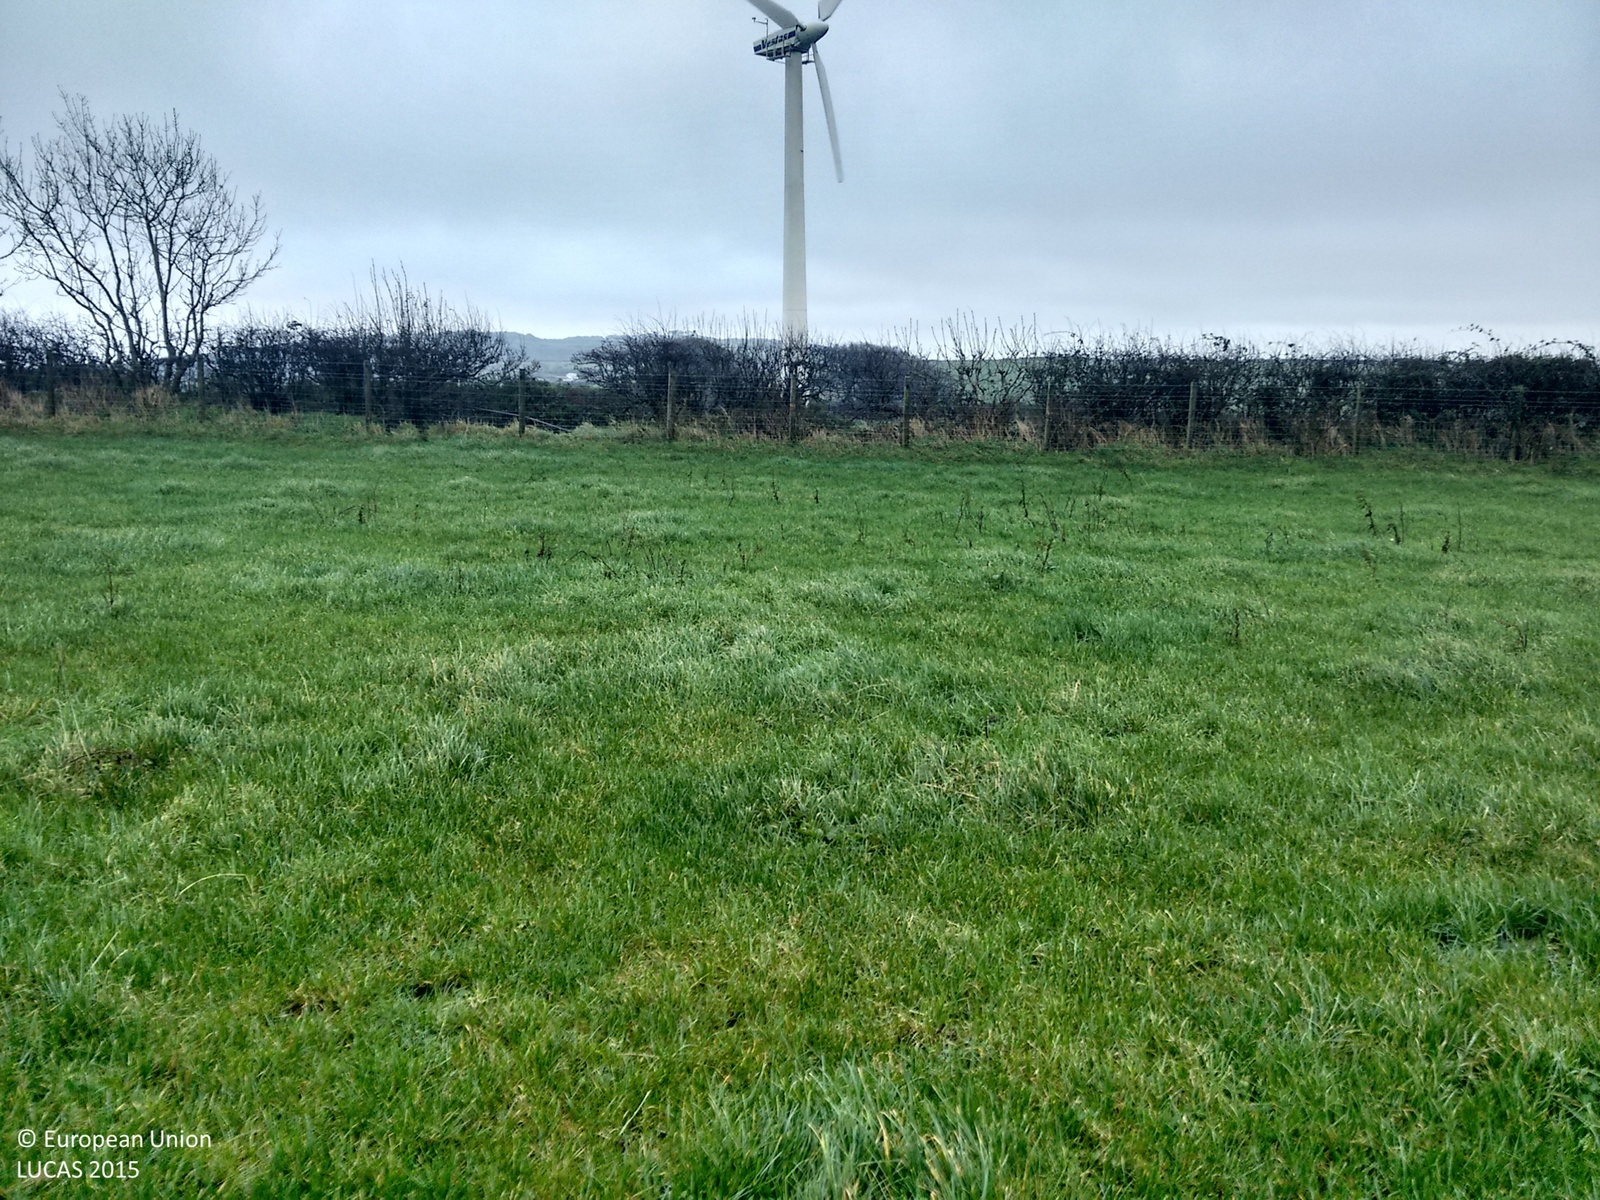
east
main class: Grassland
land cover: Grassland without tree/shrub cover
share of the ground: > 75 %
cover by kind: herbaceous plants 100 %
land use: Agriculture (excluding fallow land and kitchen gardens)
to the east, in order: Grassland without tree/shrub cover; Fences; Managed hedges; Tracks; Abandoned hedges; Fences; Grassland without tree/shrub cover; Artificial constructions in urban areas; Grassland without tree/shrub cover; Fences; Abandoned hedges; Artificial constructions in urban areas; Broadleaved woodland
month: November
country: GB
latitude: 54.6134
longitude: -5.7894
